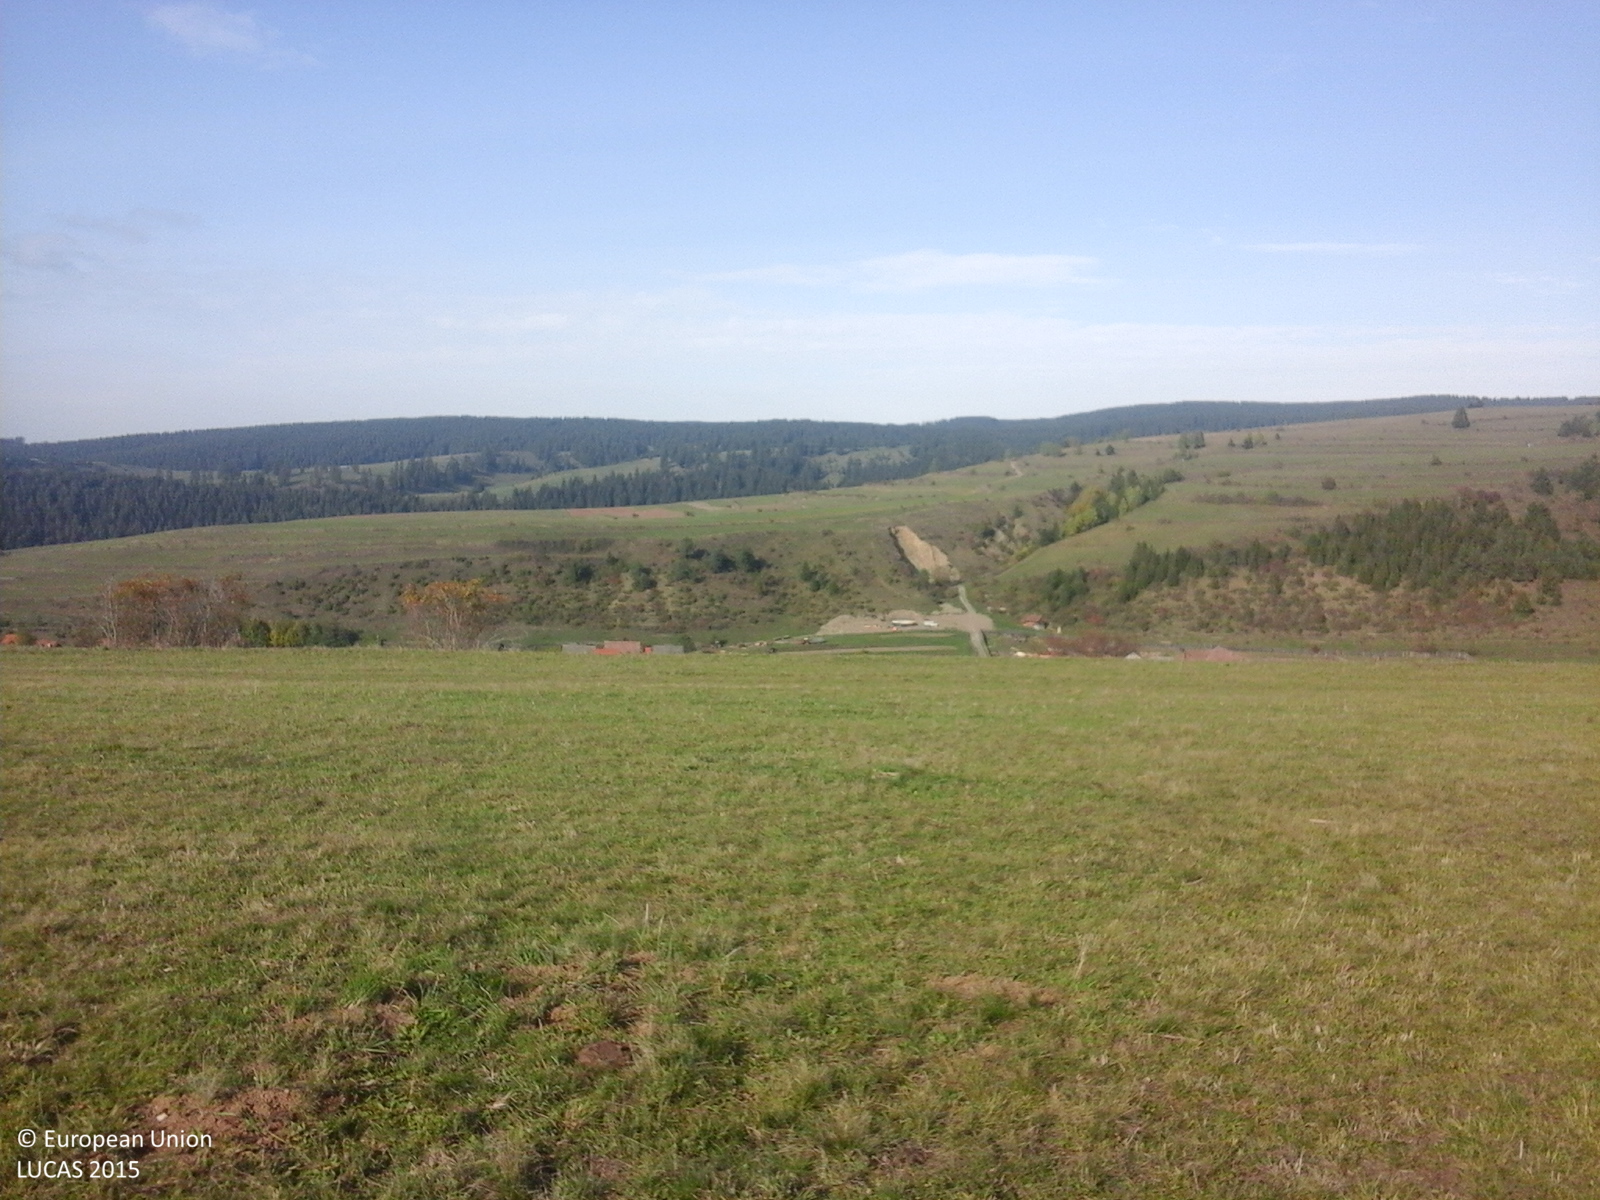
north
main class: Grassland
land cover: Grassland without tree/shrub cover
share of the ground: > 75 %
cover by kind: herbaceous plants 100 %
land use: Agriculture (excluding fallow land and kitchen gardens)
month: October
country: RO
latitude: 46.3867
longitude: 25.8637
